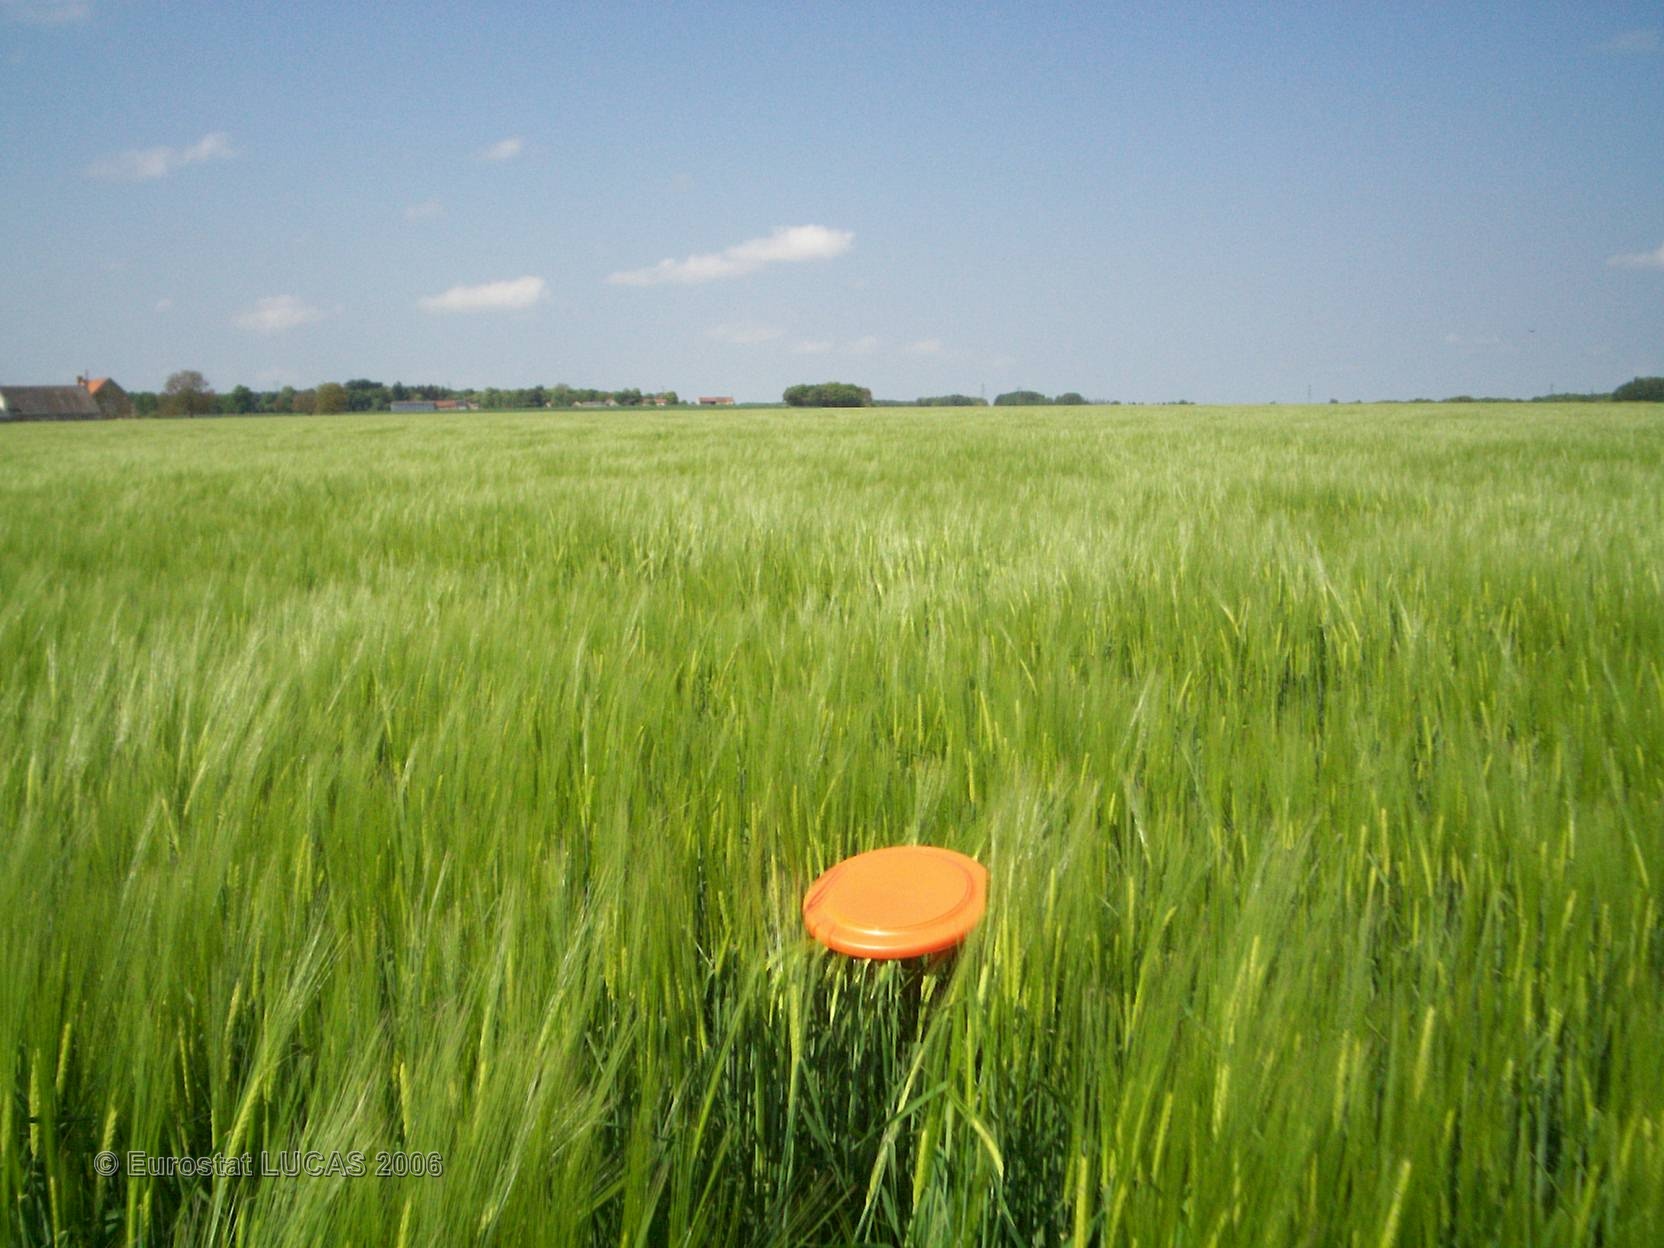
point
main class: Cropland
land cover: Barley
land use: Agriculture (excluding fallow land and kitchen gardens)
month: May
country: FR
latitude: 47.4014
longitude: 0.1573
